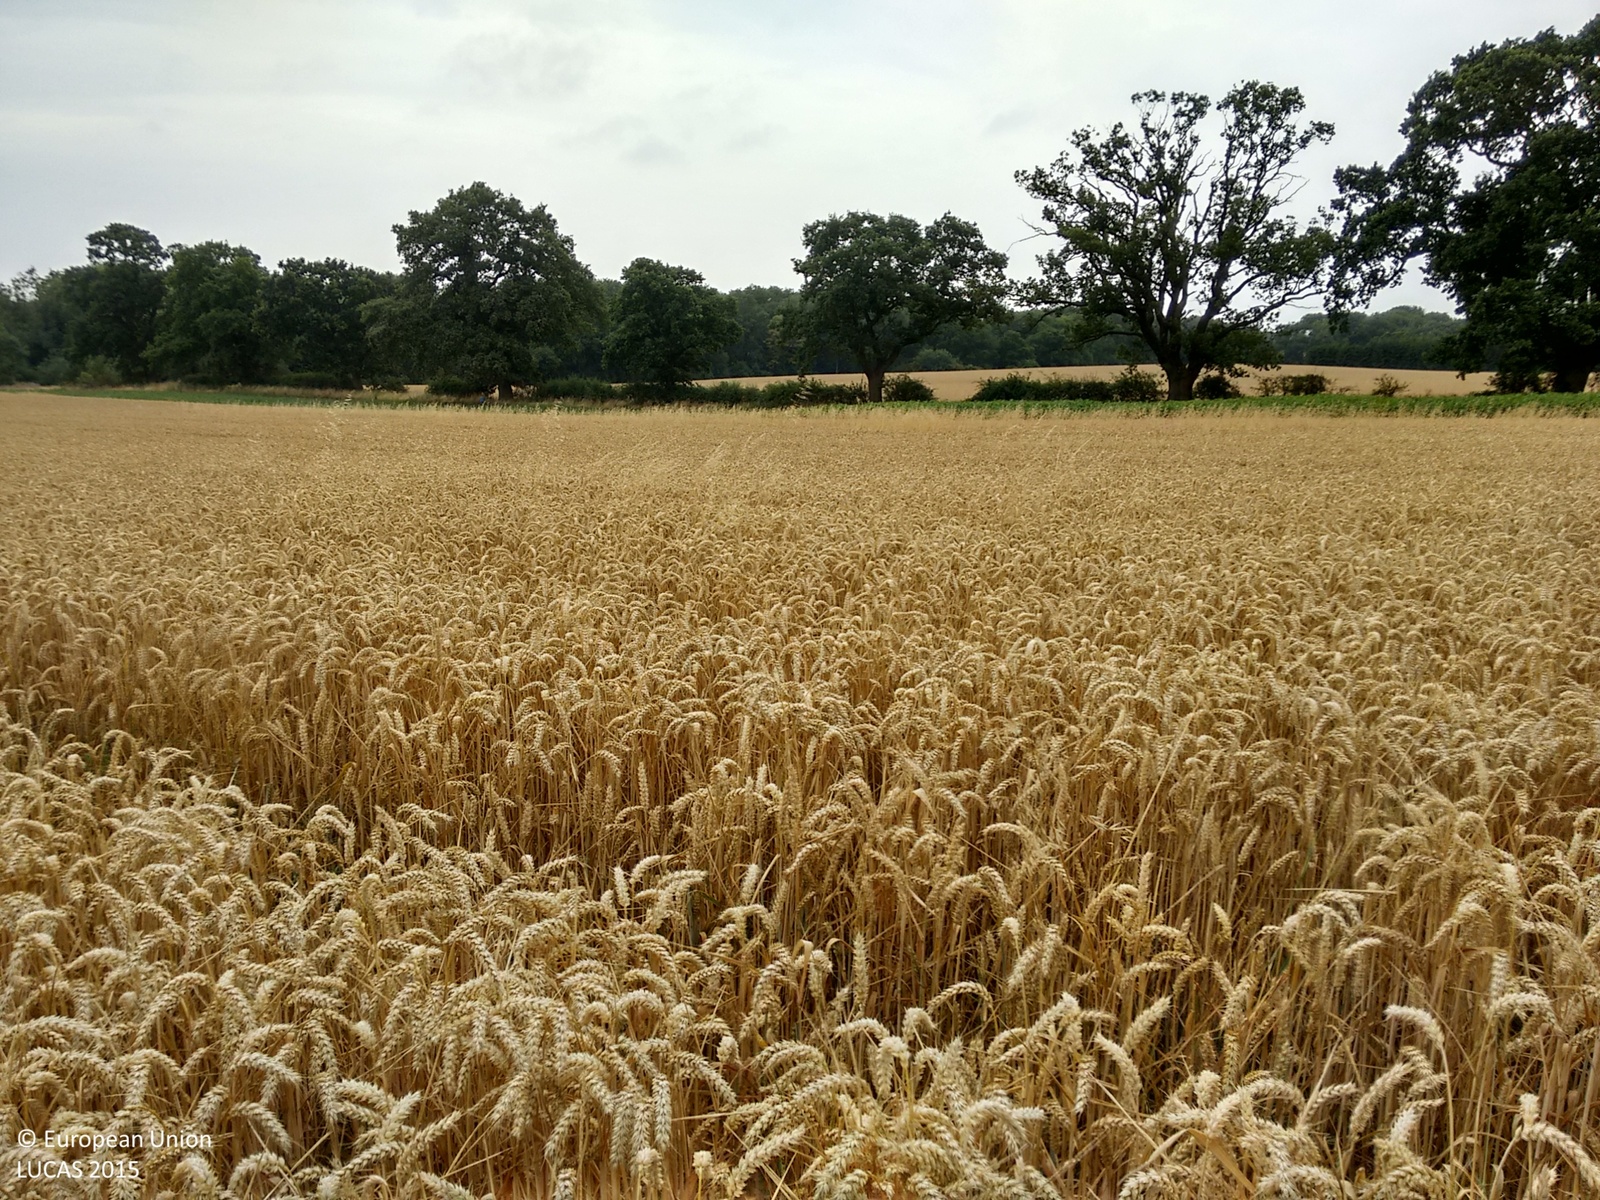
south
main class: Cropland
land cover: Common wheat
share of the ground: > 75 %
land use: Agriculture (excluding fallow land and kitchen gardens)
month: August
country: GB
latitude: 52.2987
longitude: -0.8199
